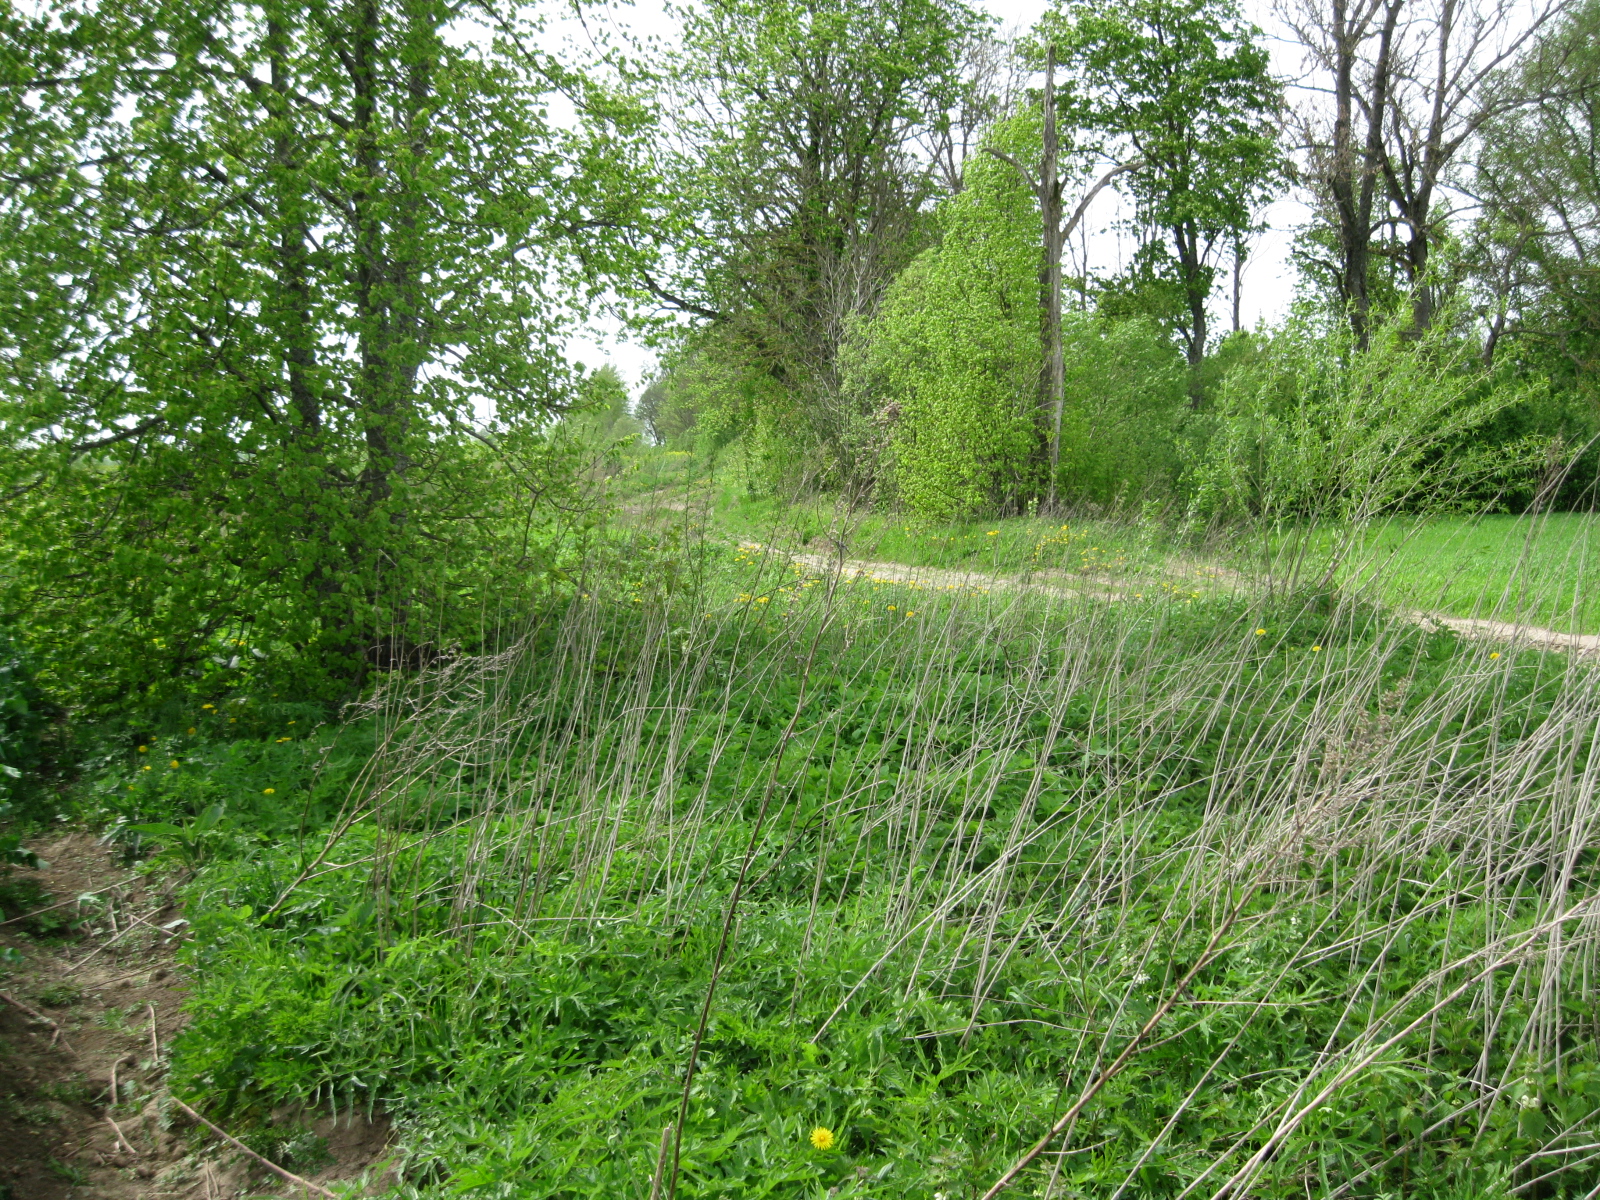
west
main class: Grassland
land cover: Spontaneously vegetated surfaces
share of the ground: > 75 %
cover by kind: herbaceous plants 100 %
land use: Fallow land
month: May
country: LT
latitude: 56.2963
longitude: 24.2959
